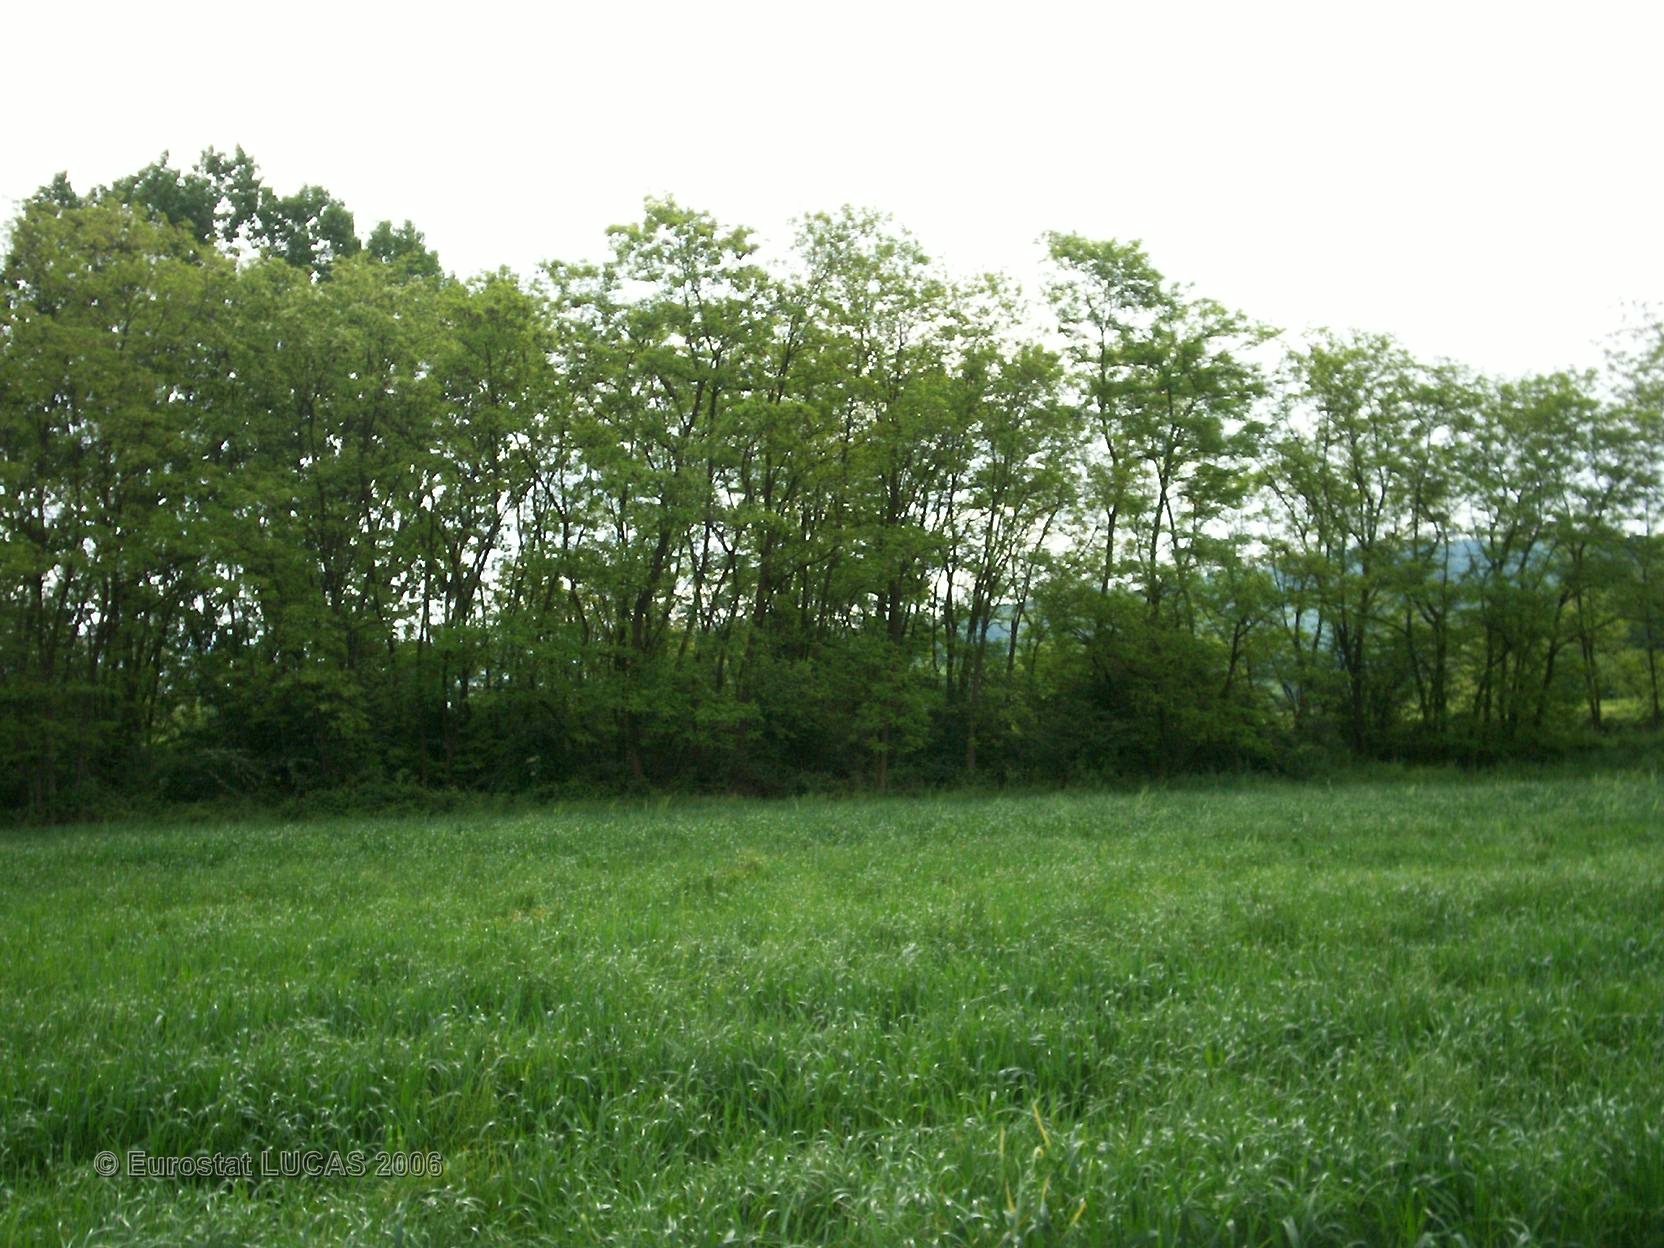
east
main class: Grassland
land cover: Grassland without tree/shrub cover
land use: Agriculture (excluding fallow land and kitchen gardens)
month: May
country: FR
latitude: 45.8811
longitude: 4.7848
